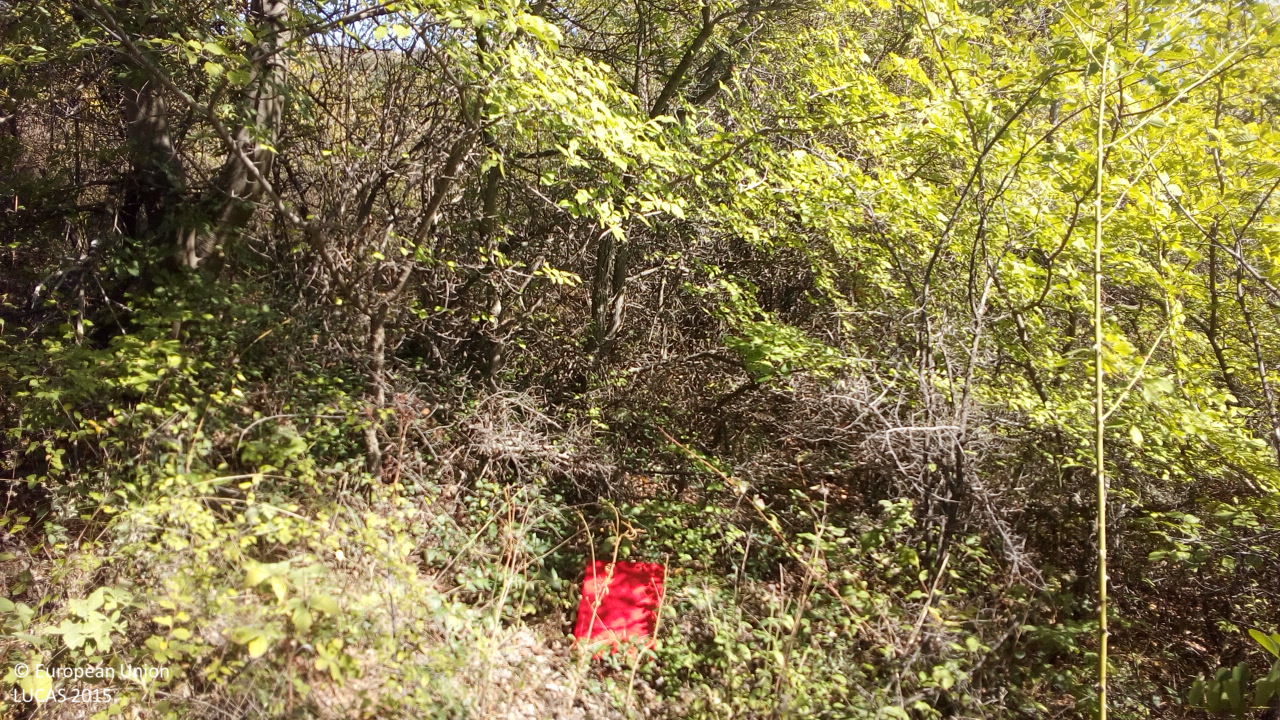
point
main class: Woodland
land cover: Broadleaved woodland
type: thermophilous deciduous forest
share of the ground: > 75 %
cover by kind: broadleaved forest trees 95 %, unconsolidated bare surface 5 %
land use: Forestry
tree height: < 5 m
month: October
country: BG
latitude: 42.0545
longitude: 22.9639
